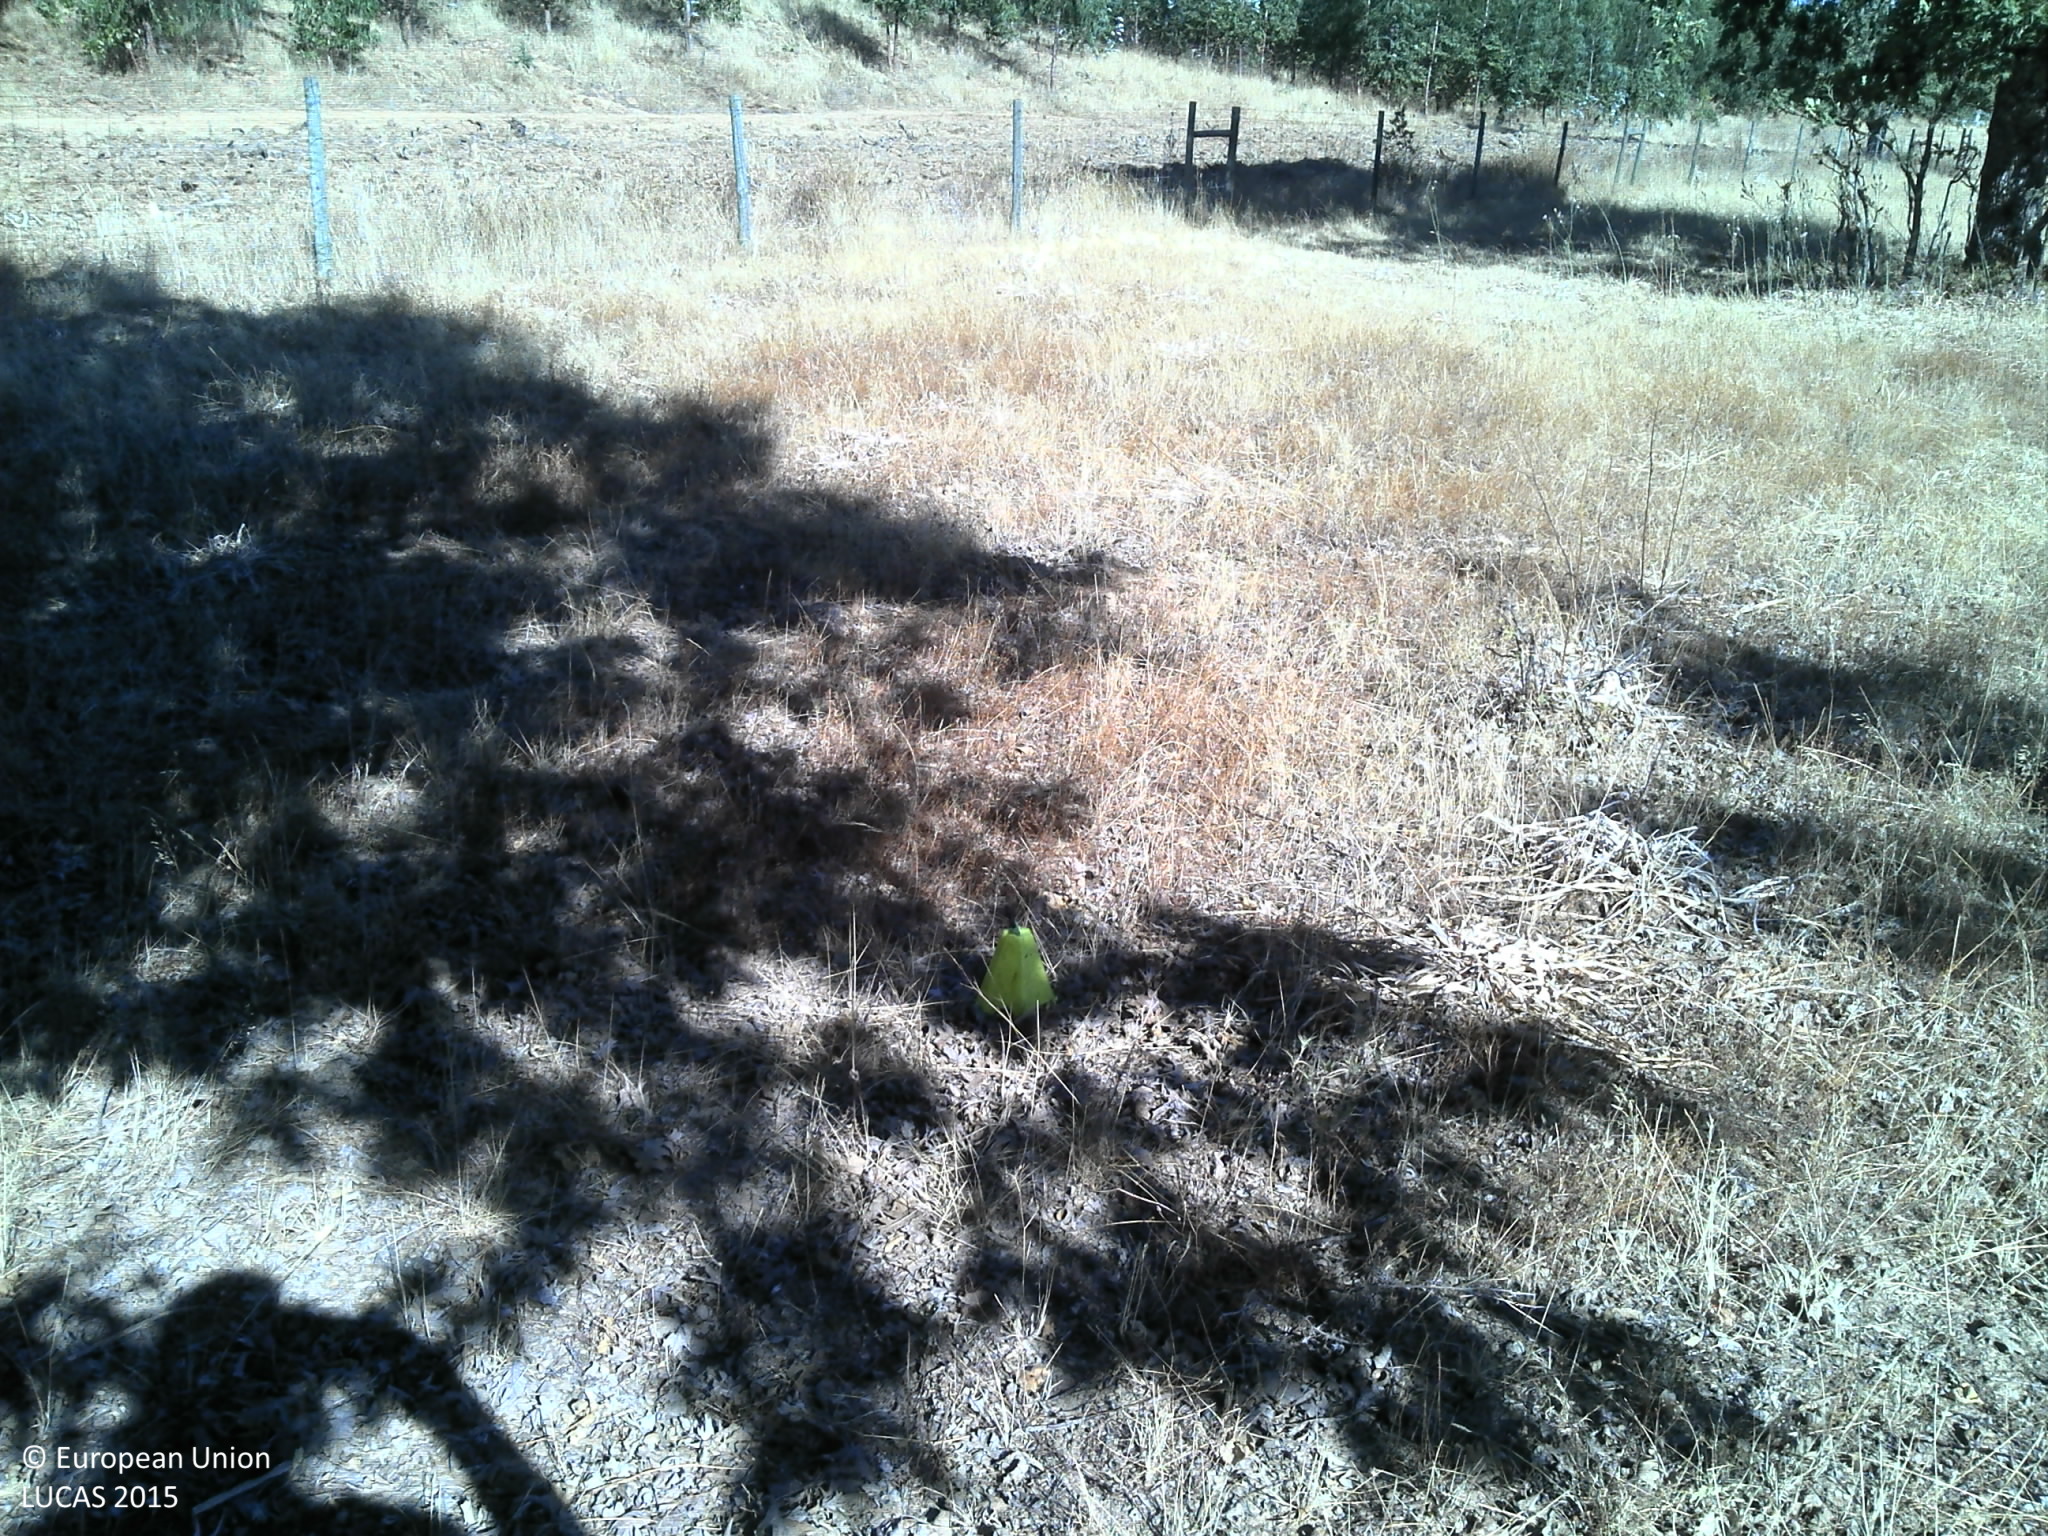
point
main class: Woodland
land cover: Broadleaved woodland
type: broadleaved evergreen forest
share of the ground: 25 - 50 %
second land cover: Grassland without tree/shrub cover
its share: 25 - 50 %
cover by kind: unconsolidated bare surface 50 %, broadleaved forest trees 25 %, herbaceous plants 25 %
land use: Forestry
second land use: Agriculture (excluding fallow land and kitchen gardens)
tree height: > 5 m
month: July
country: PT
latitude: 39.3667
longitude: -7.5843
